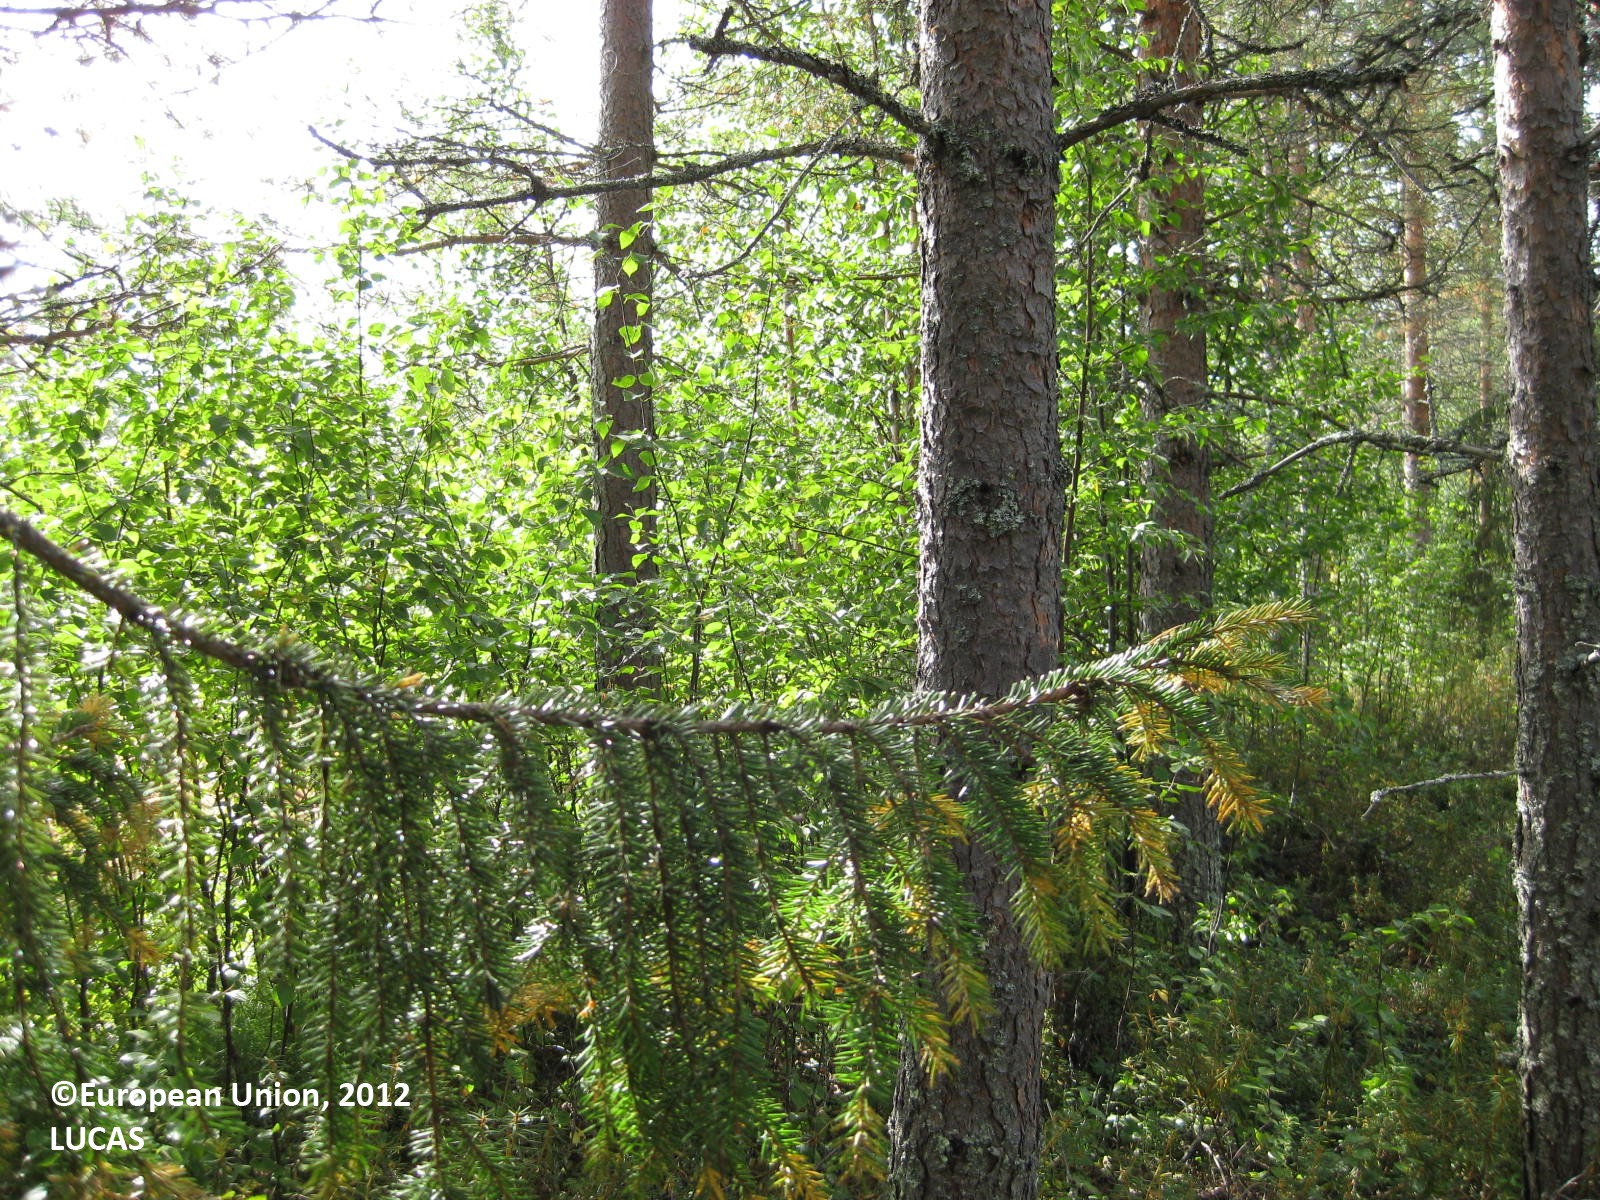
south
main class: Woodland
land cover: Pine dominated mixed woodland
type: boreal forest
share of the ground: > 75 %
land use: Forestry
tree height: > 5 m
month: August
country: FI
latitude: 66.2445
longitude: 28.8722
